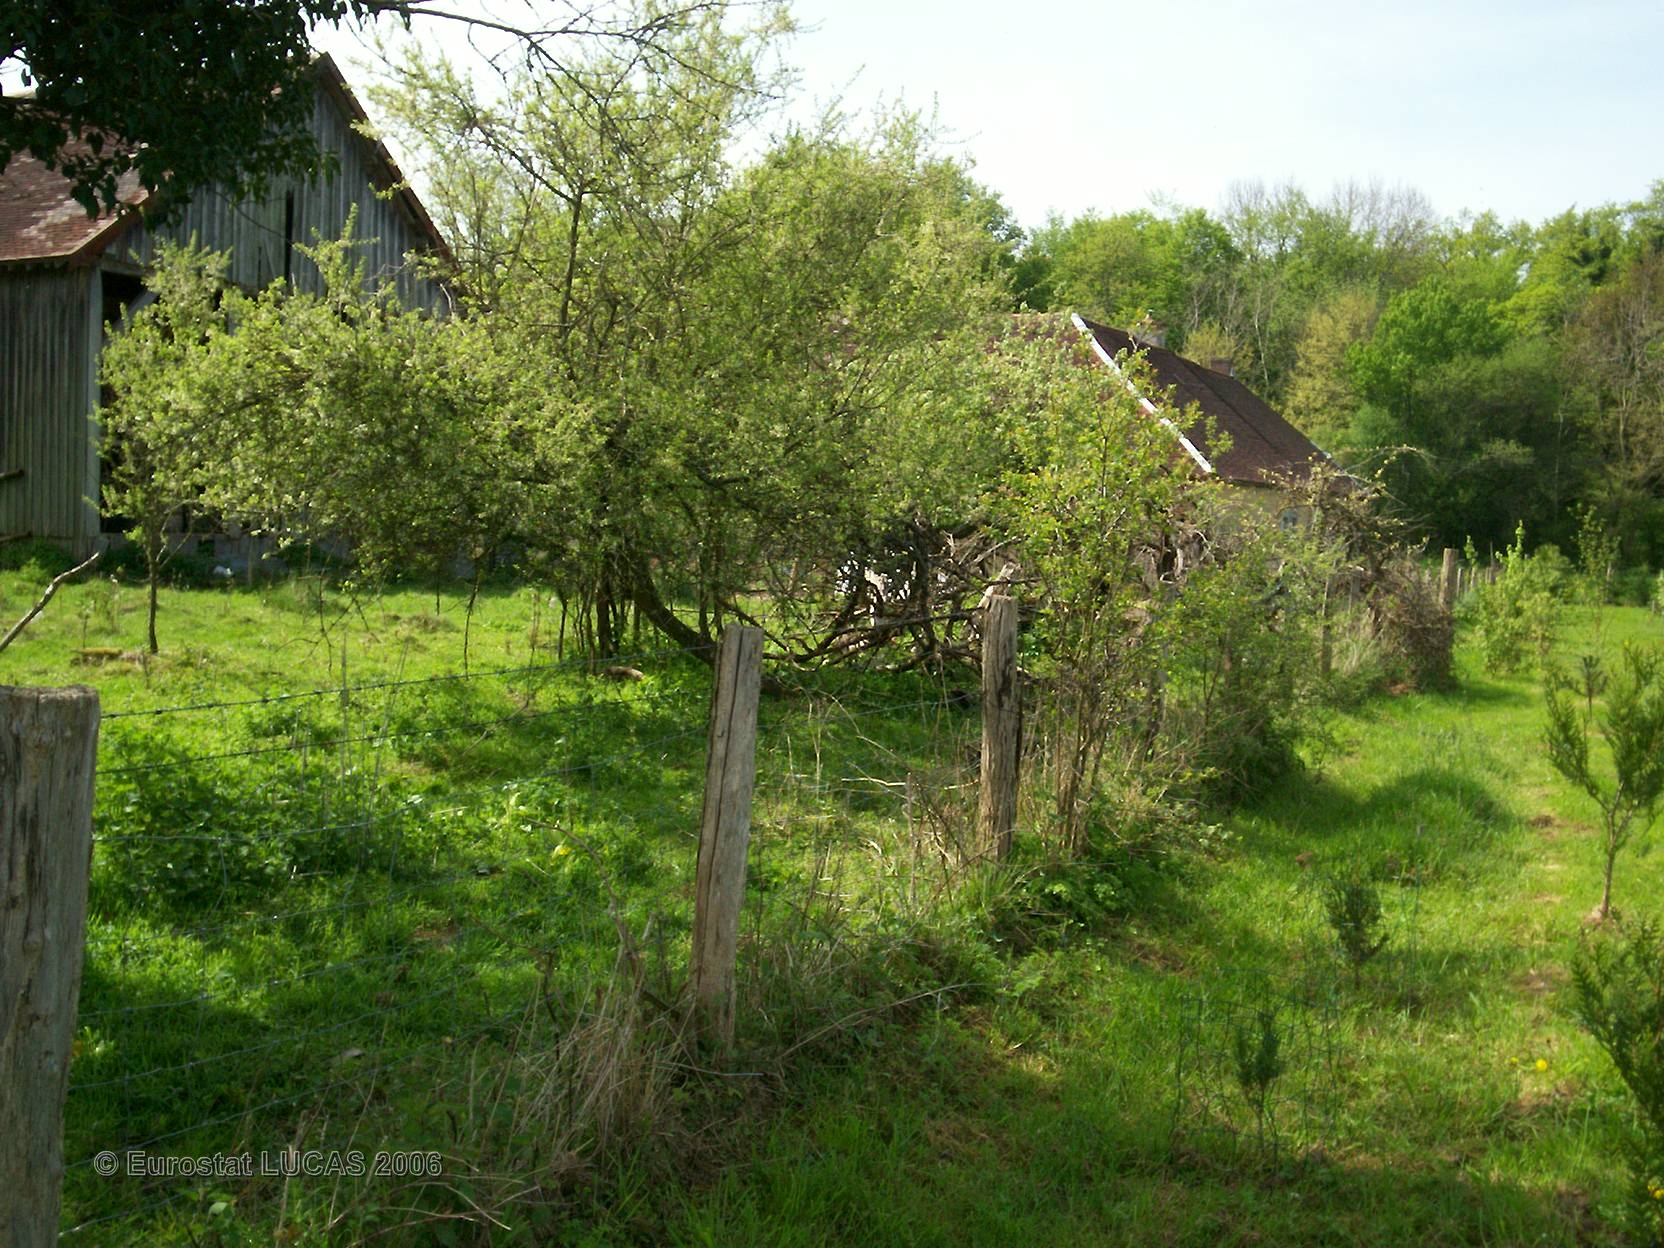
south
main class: Cropland
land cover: Other fruit trees and berries
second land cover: Grassland with sparse tree/shrub cover
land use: Kitchen garden
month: May
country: FR
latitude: 48.0077
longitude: 4.0317
